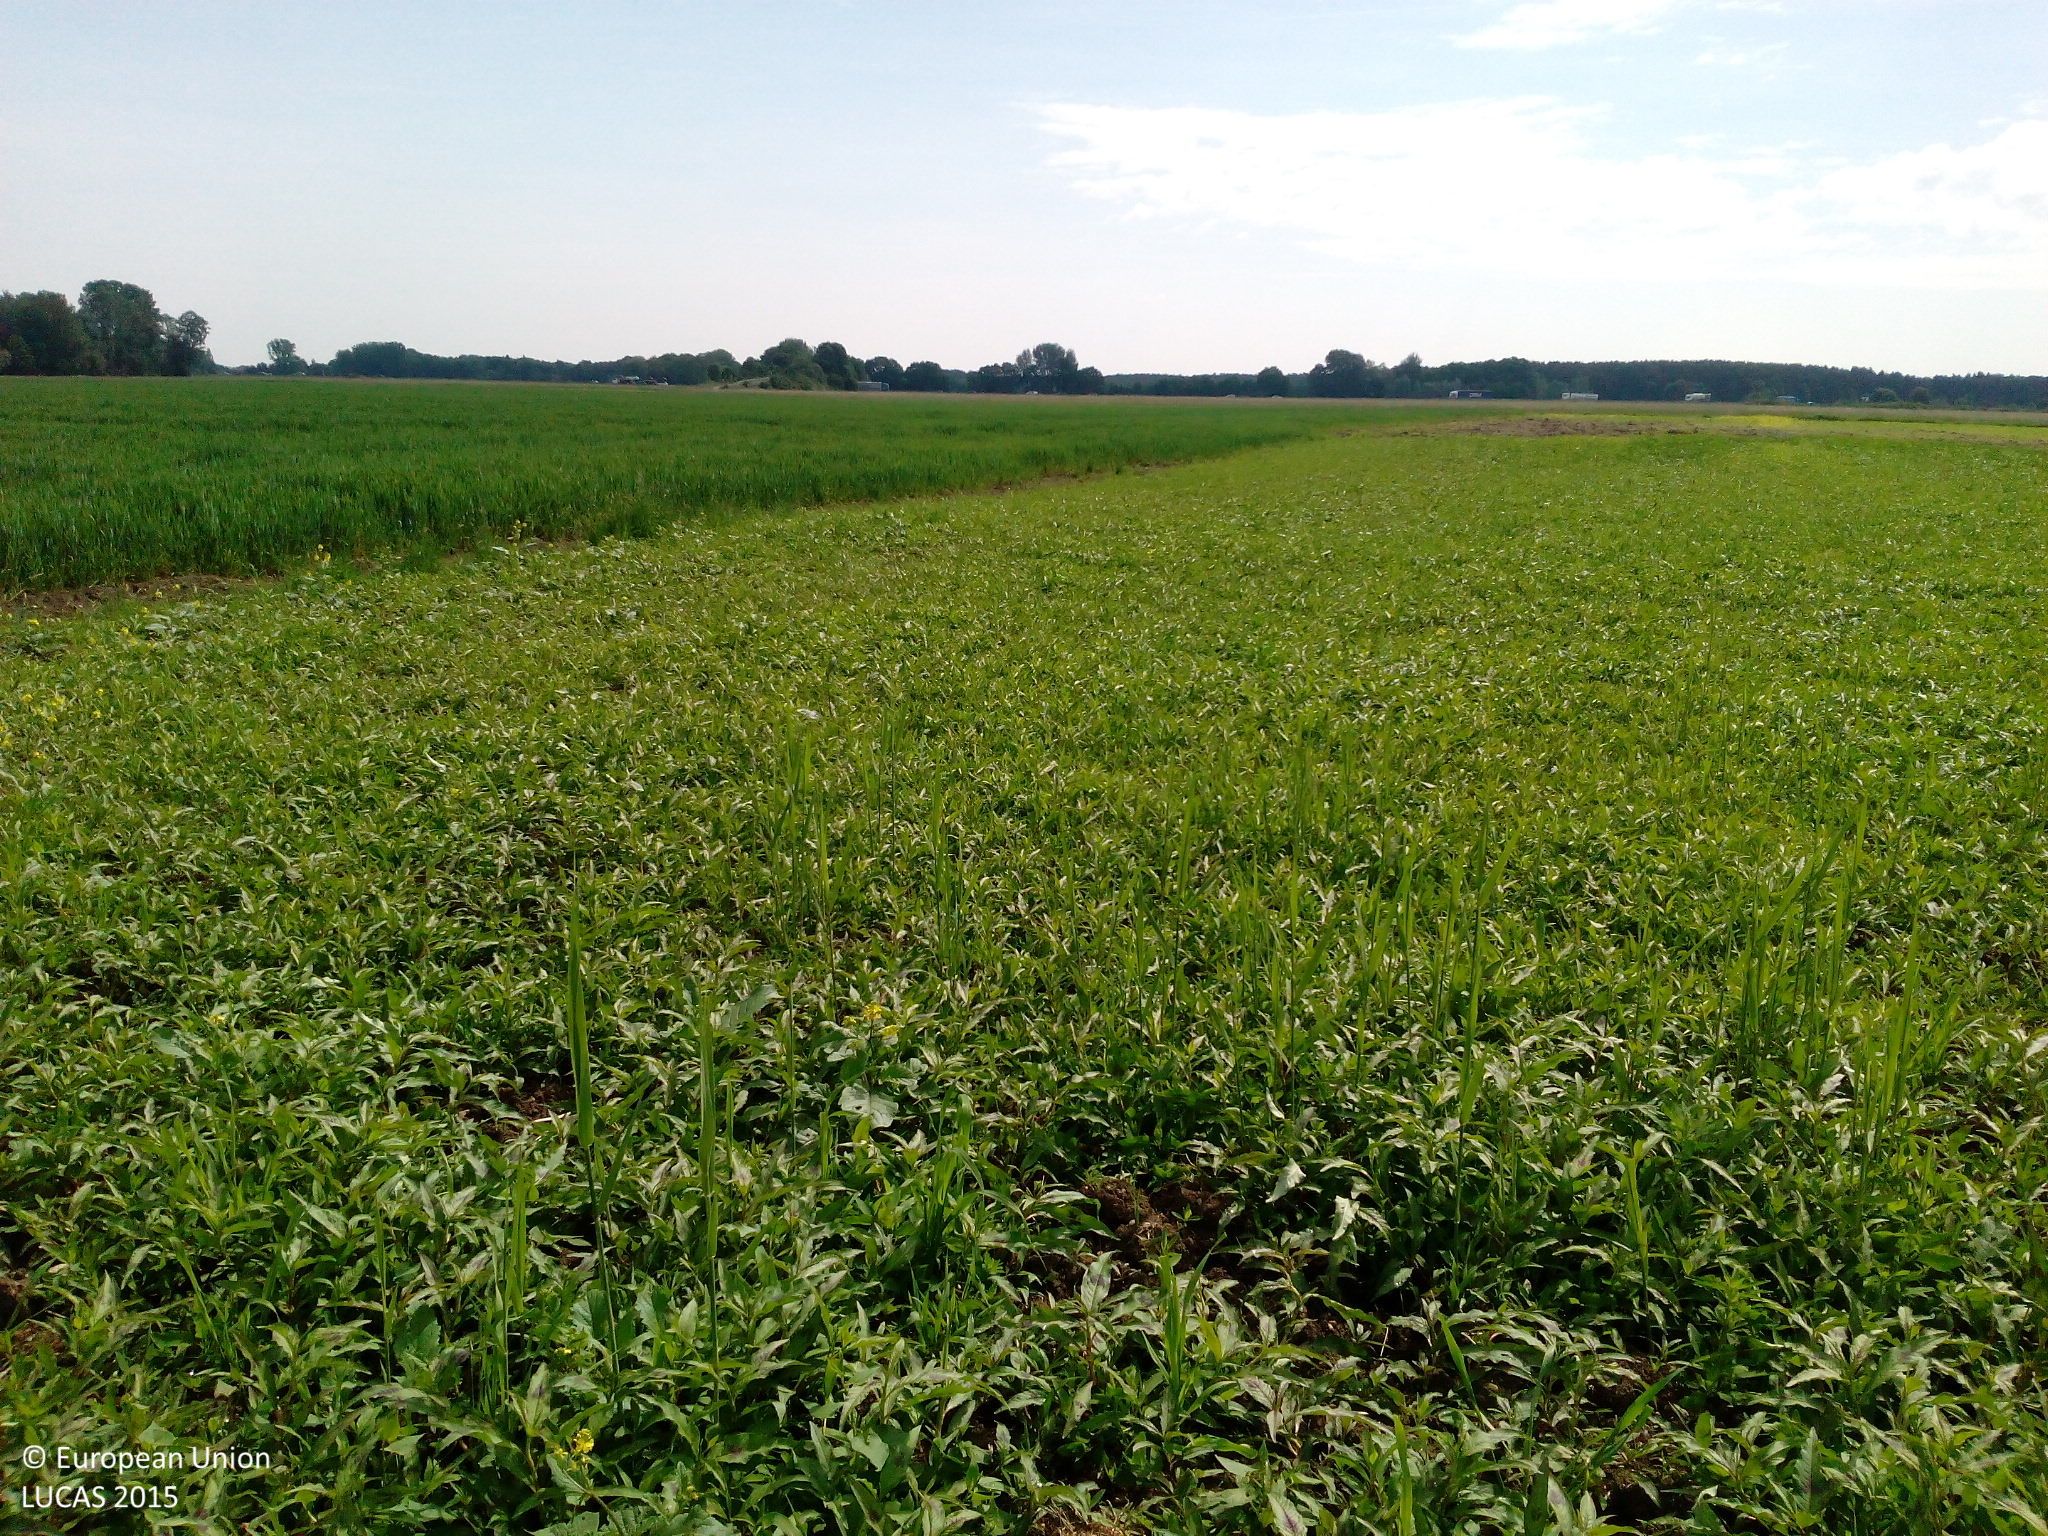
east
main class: Grassland
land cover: Spontaneously vegetated surfaces
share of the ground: 25 - 50 %
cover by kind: unconsolidated bare surface 60 %, herbaceous plants 40 %
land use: Agriculture (excluding fallow land and kitchen gardens)
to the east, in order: Tracks; Spontaneously vegetated surfaces; Triticale; Grass margins; Tracks; Grassland without tree/shrub cover
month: May
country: DE
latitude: 48.6995
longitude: 11.4803
